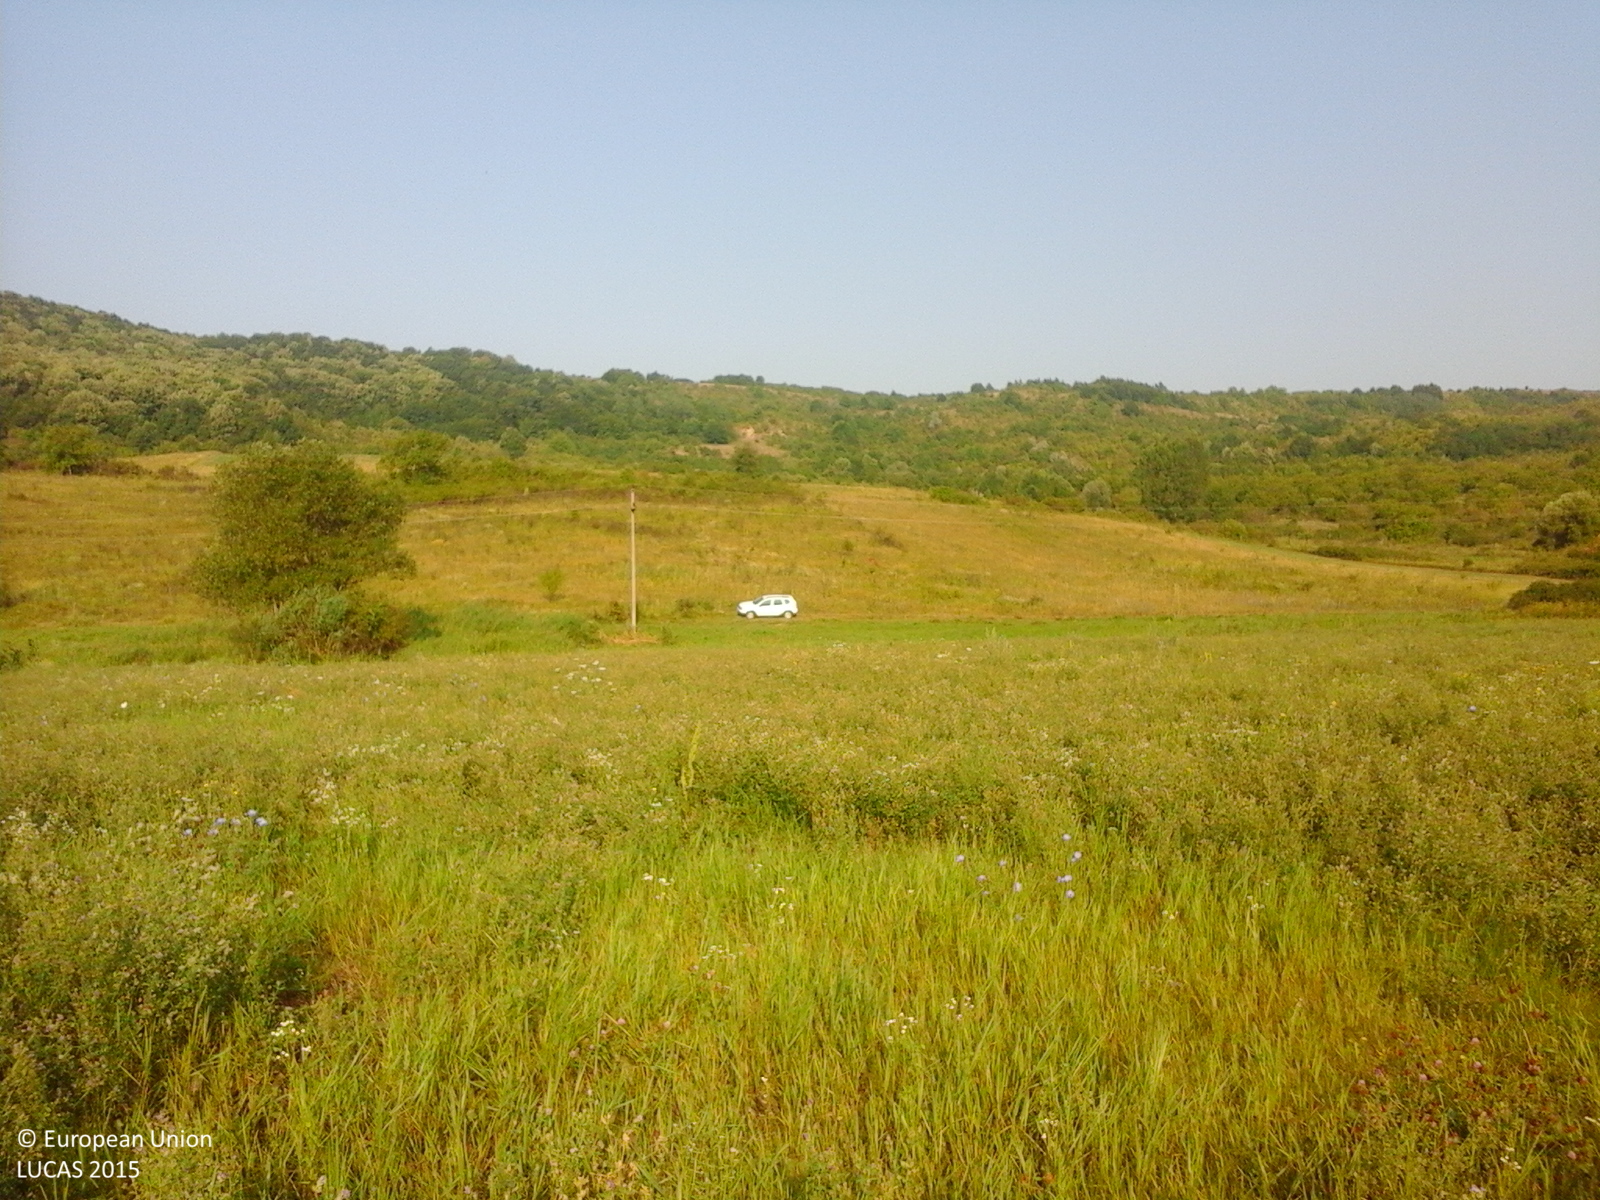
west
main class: Grassland
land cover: Spontaneously vegetated surfaces
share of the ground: > 75 %
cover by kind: herbaceous plants 100 %
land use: Fallow land
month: July
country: RO
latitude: 46.5088
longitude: 27.6437
